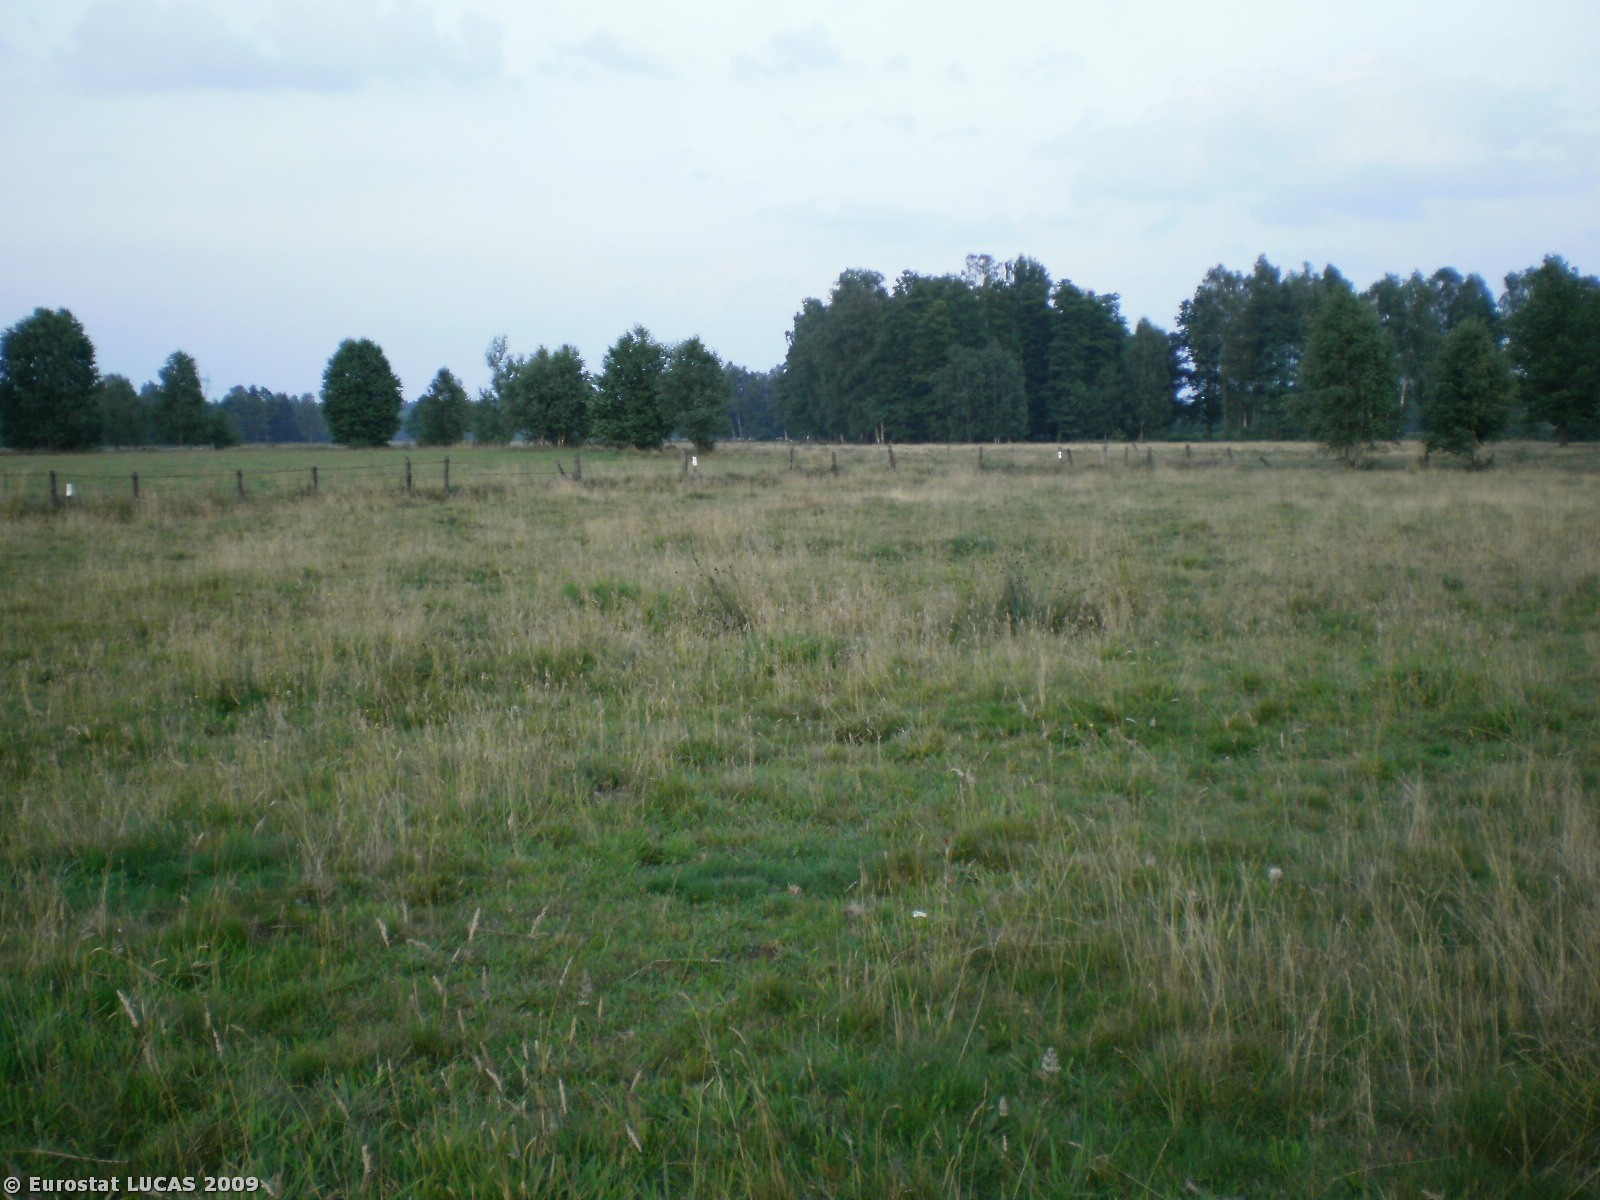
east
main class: Grassland
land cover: Grassland without tree/shrub cover
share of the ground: > 75 %
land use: Agriculture (excluding fallow land and kitchen gardens)
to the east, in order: Grassland without tree/shrub cover; Fences; Grassland without tree/shrub cover; Ditches and canals; Single bushes/trees; Fences; Grassland without tree/shrub cover; Spontaneously vegetated surfaces; Fences; Ditches and canals; Grassland without tree/shrub cover
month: July
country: PL
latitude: 53.5129
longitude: 21.0372
